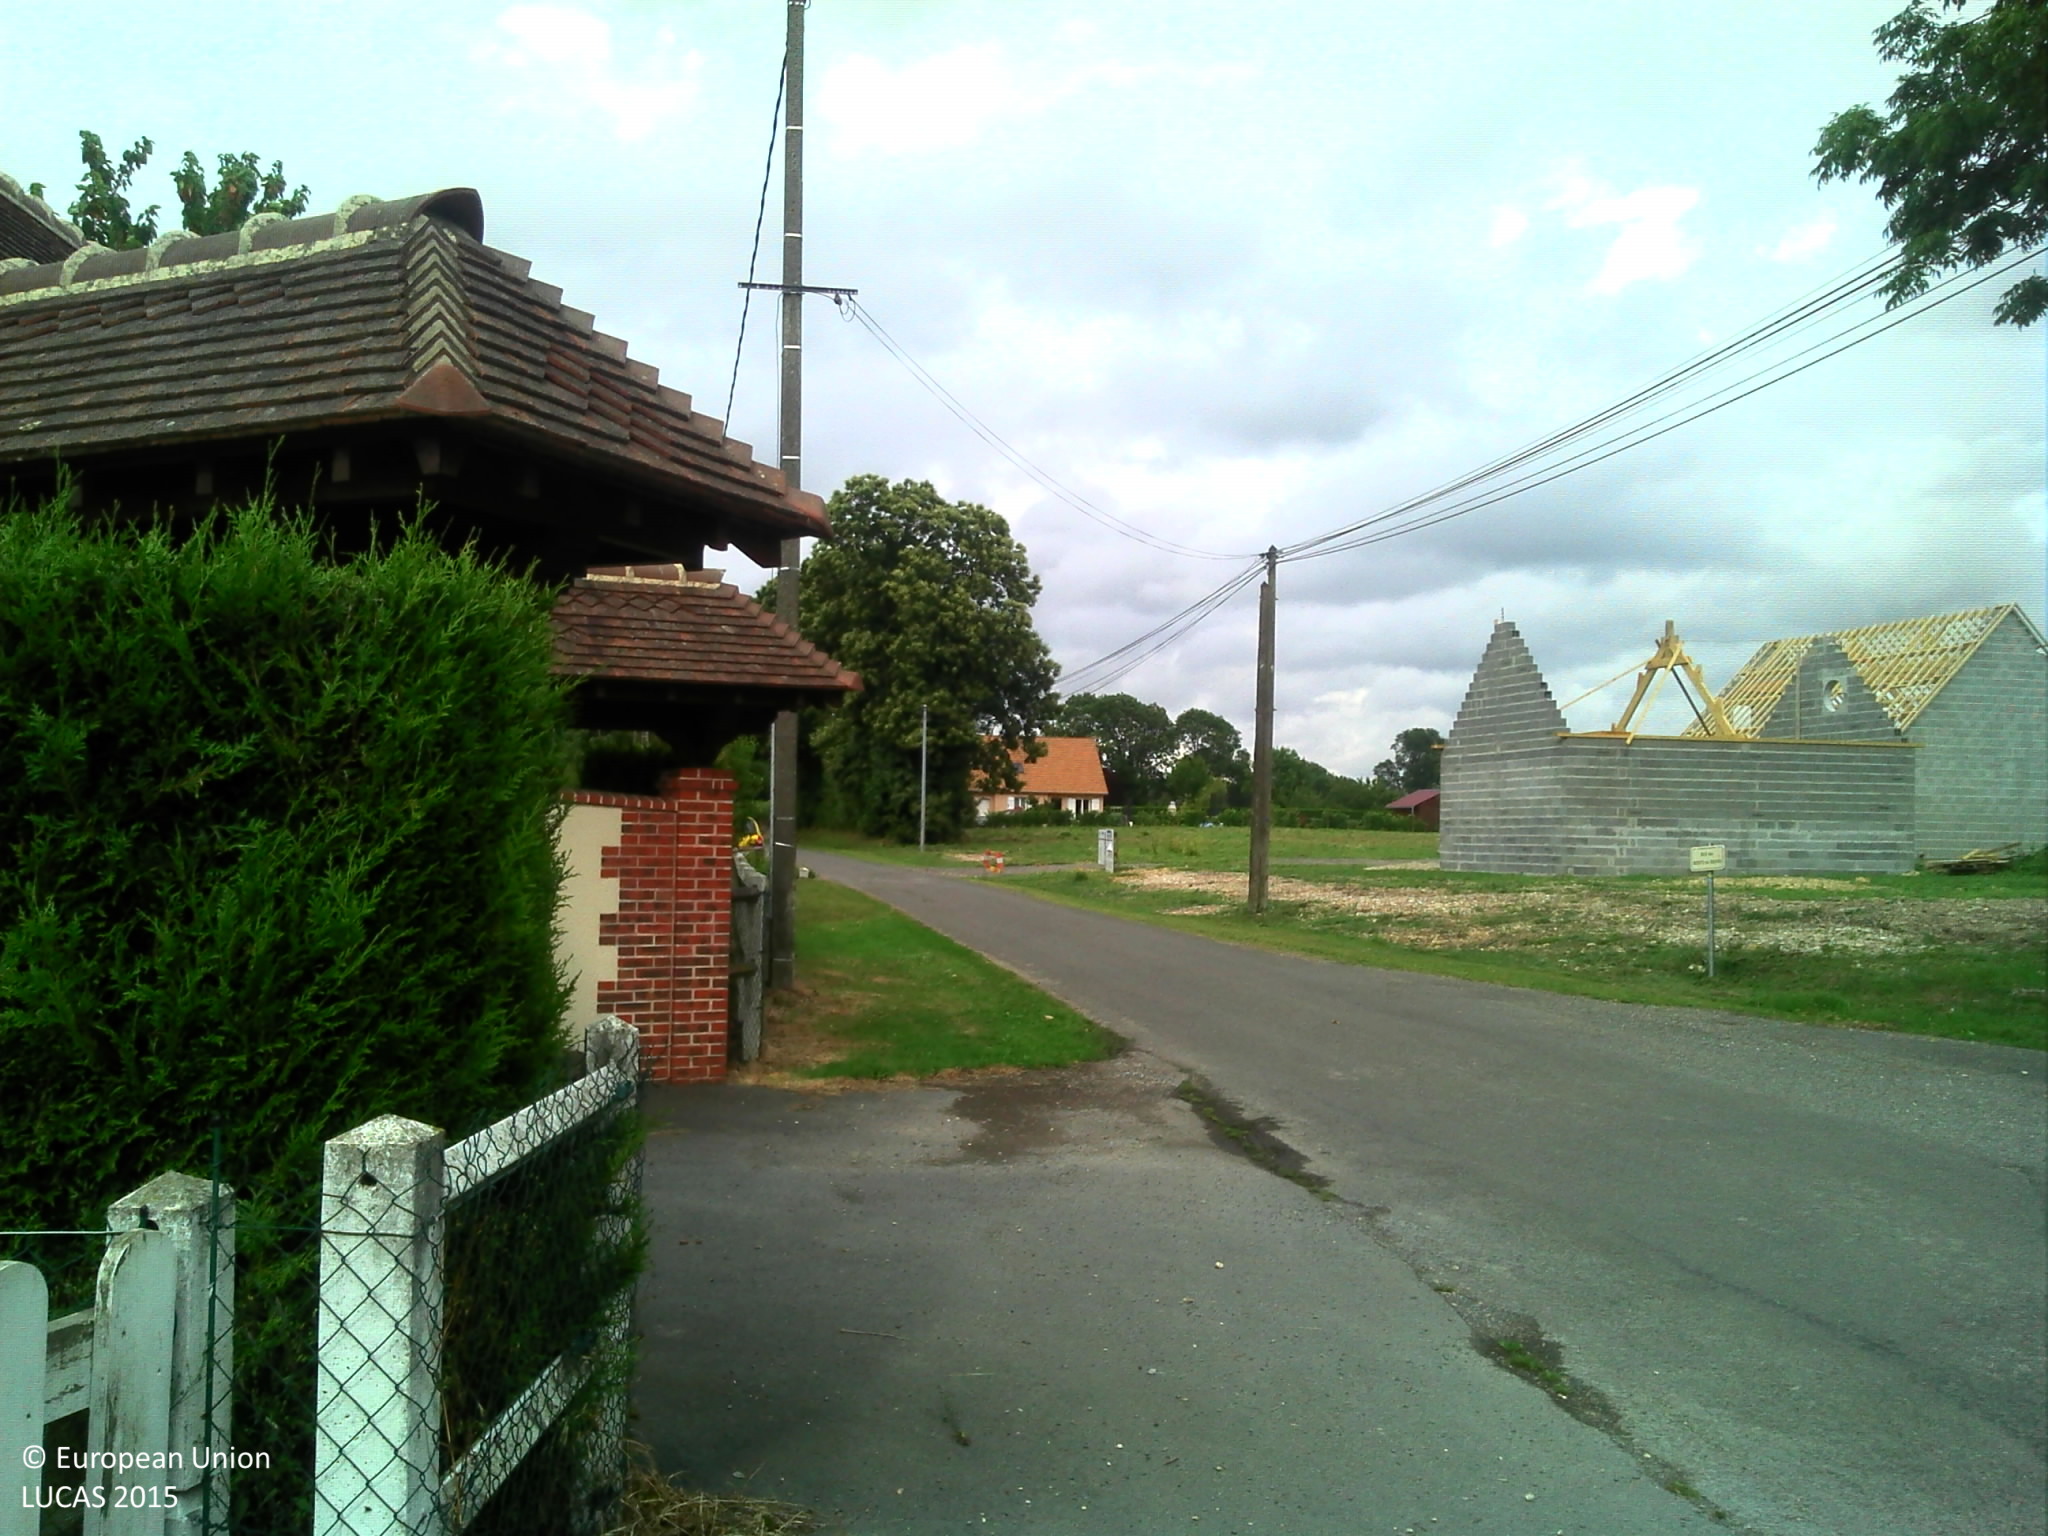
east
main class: Grassland
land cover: Grassland with sparse tree/shrub cover
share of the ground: > 75 %
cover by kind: herbaceous plants 95 %, broadleaved forest trees 5 %
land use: Residential
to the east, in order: Grassland with sparse tree/shrub cover; Artificial constructions in urban areas; Lines of trees; Dry pulses; Artificial constructions in urban areas; Dry pulses
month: July
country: FR
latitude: 49.2528
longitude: 0.3969
